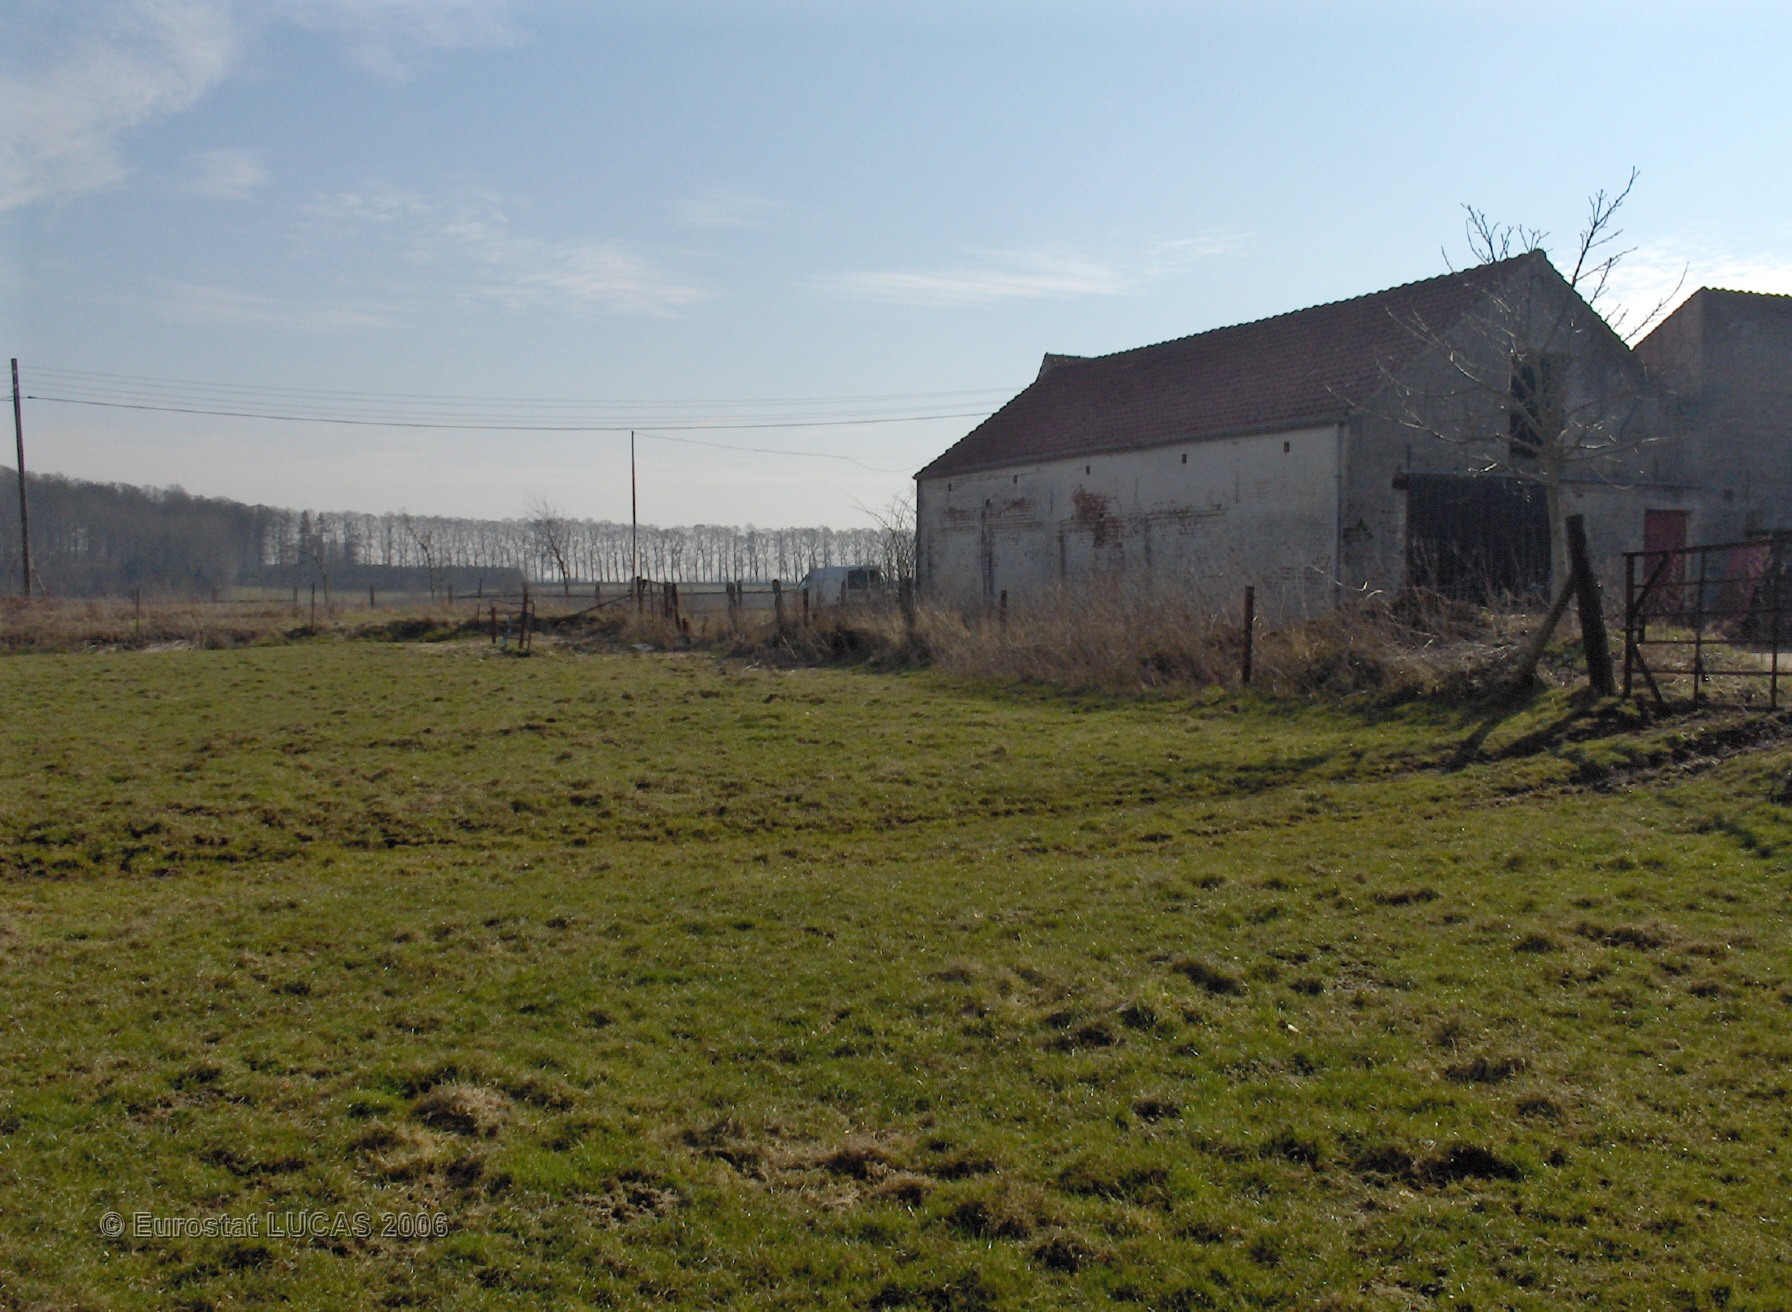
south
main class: Grassland
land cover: Grassland without tree/shrub cover
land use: Agriculture (excluding fallow land and kitchen gardens)
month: March
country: BE
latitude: 50.6268
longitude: 4.4684
